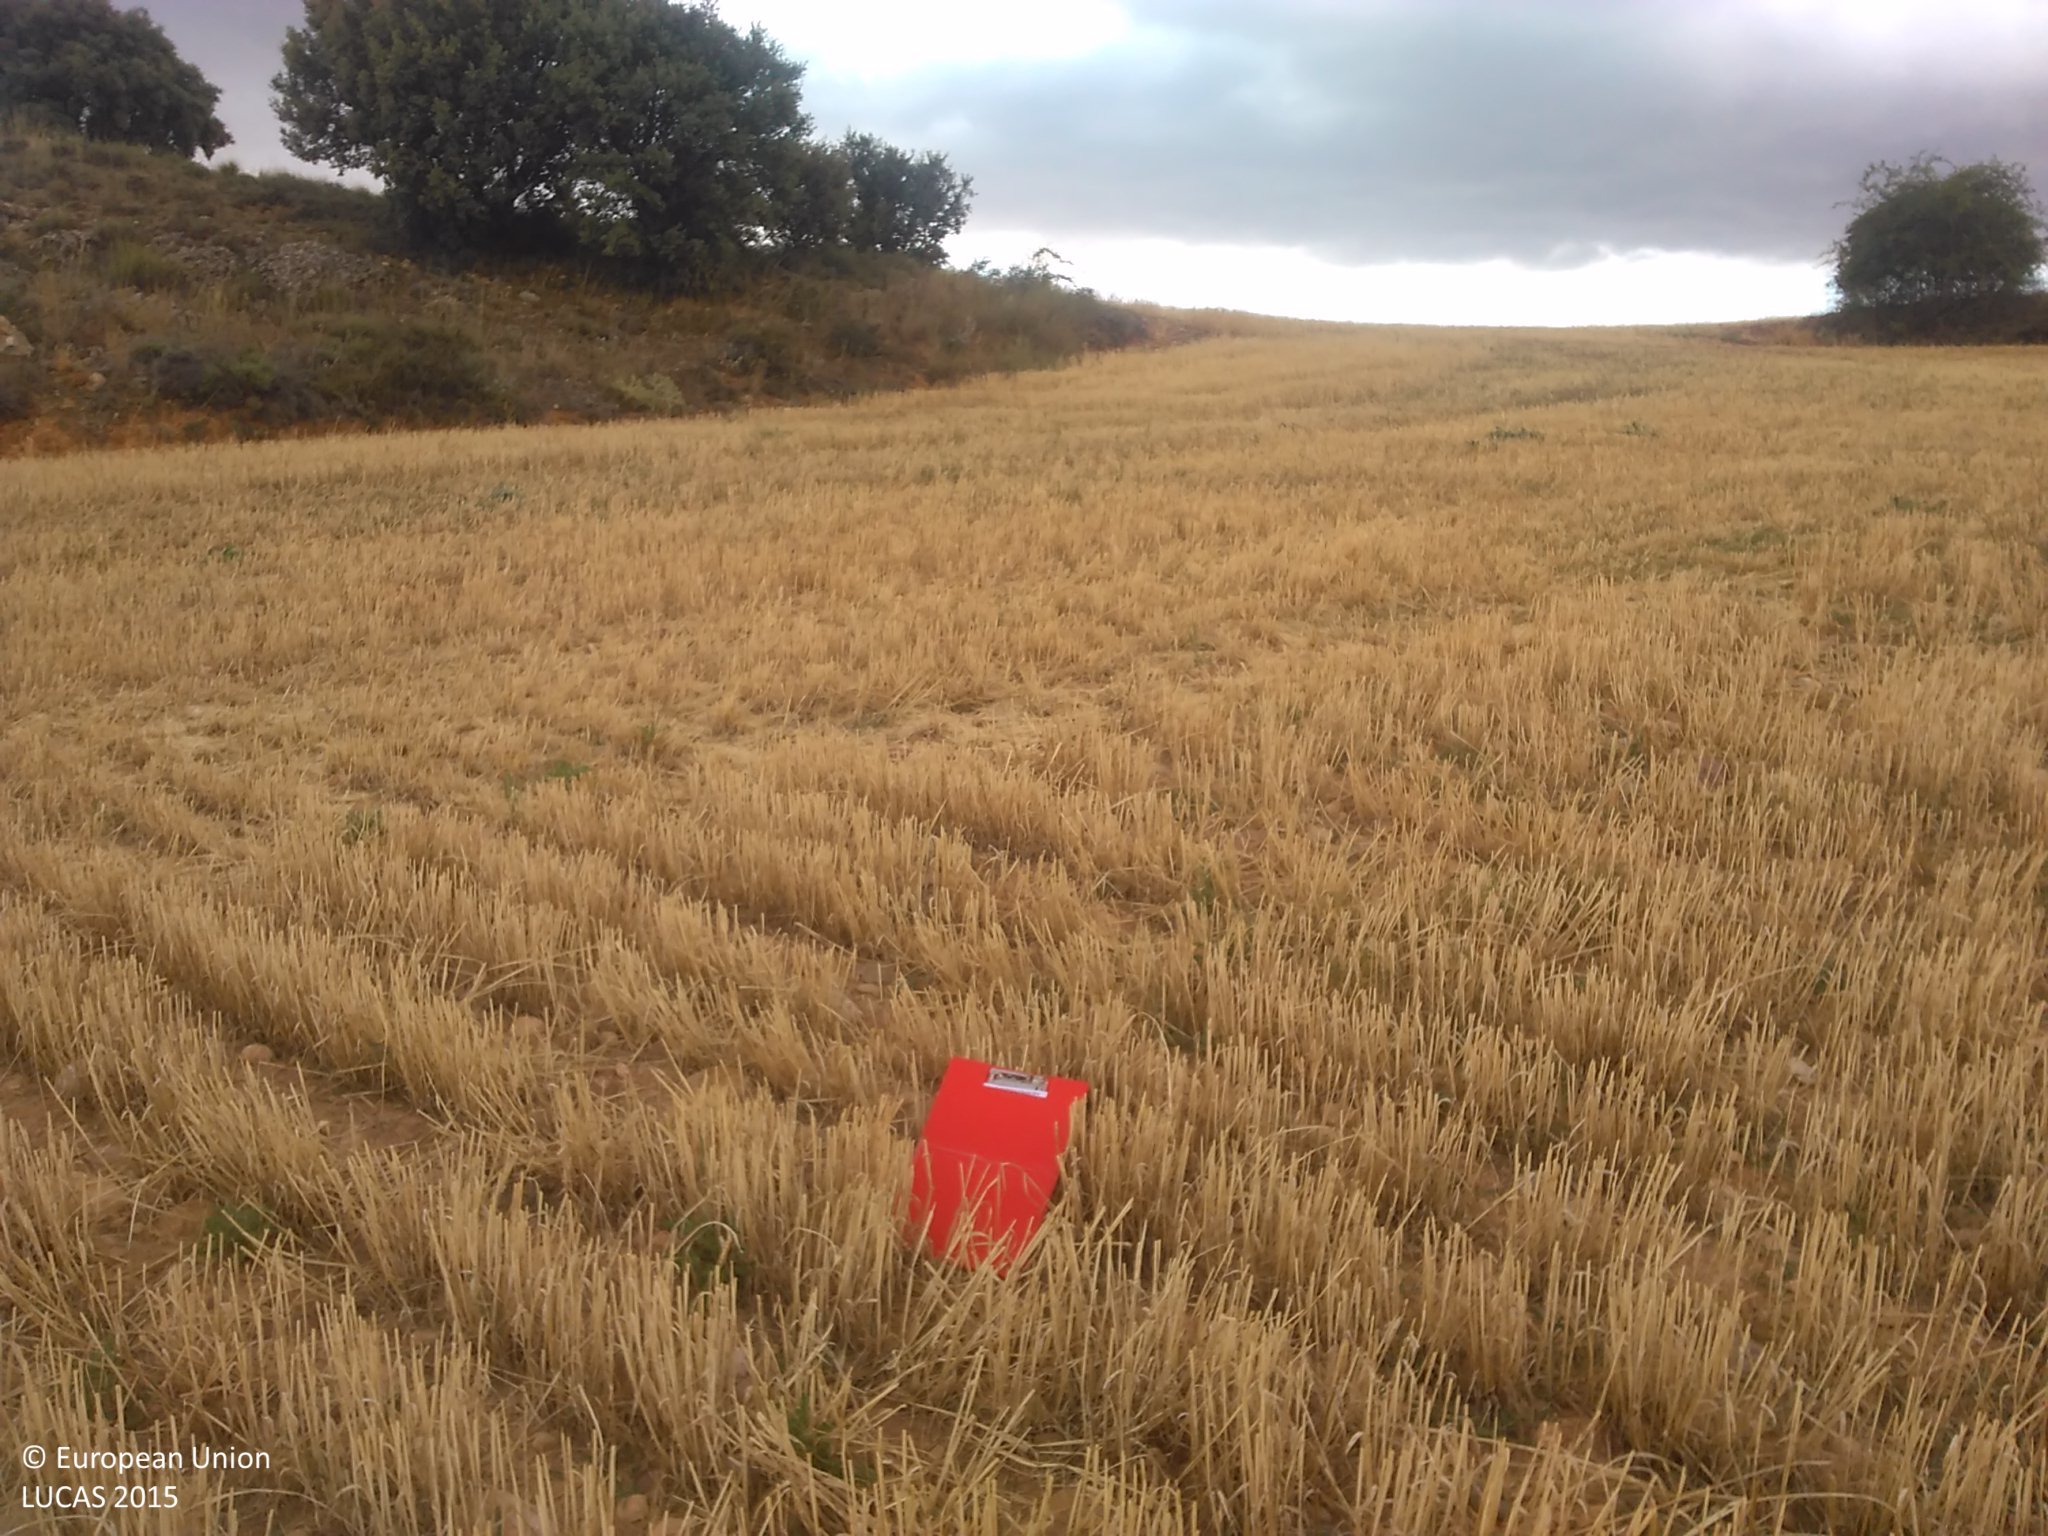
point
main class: Cropland
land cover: Barley
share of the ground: < 10 %
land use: Agriculture (excluding fallow land and kitchen gardens)
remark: Harvested field
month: July
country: ES
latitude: 41.4536
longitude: -2.2305
